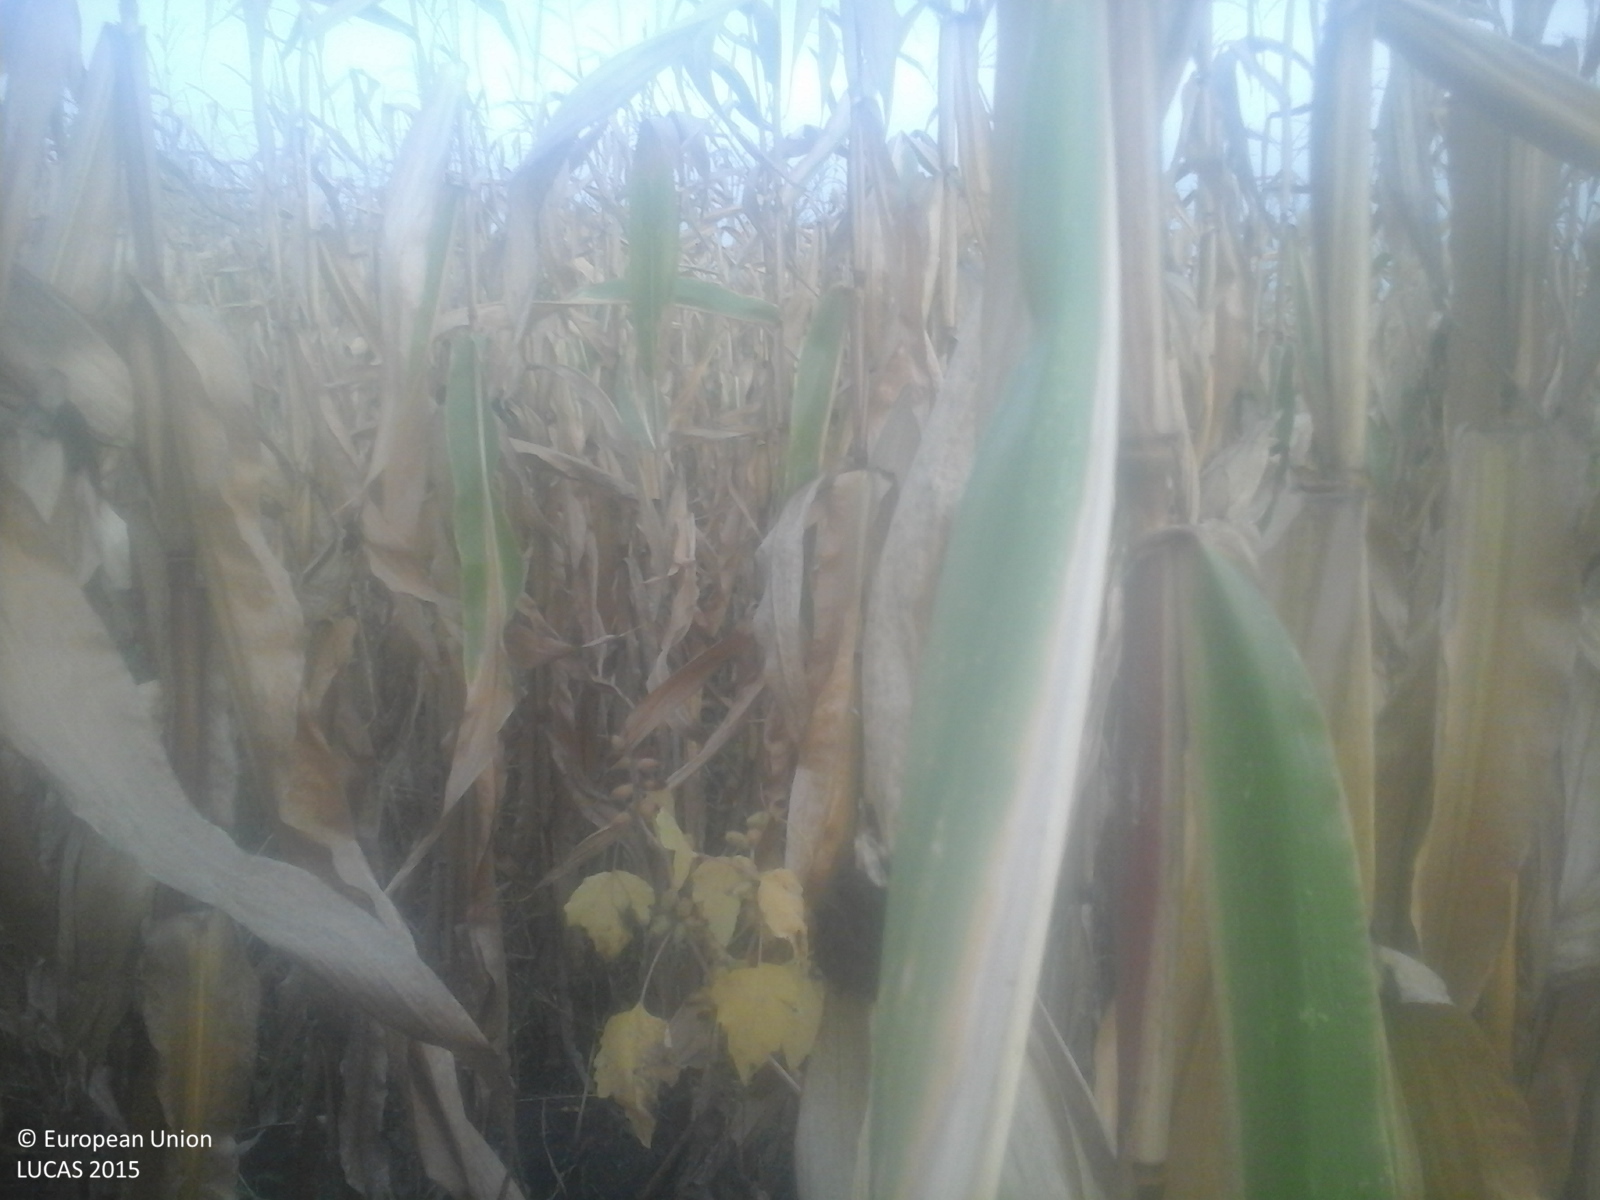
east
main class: Cropland
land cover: Maize
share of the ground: > 75 %
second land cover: Spontaneously vegetated surfaces
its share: 50 - 75 %
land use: Agriculture (excluding fallow land and kitchen gardens)
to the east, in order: Maize; Spontaneously vegetated surfaces; Grassland without tree/shrub cover
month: September
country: RO
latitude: 46.9190
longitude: 24.4410
